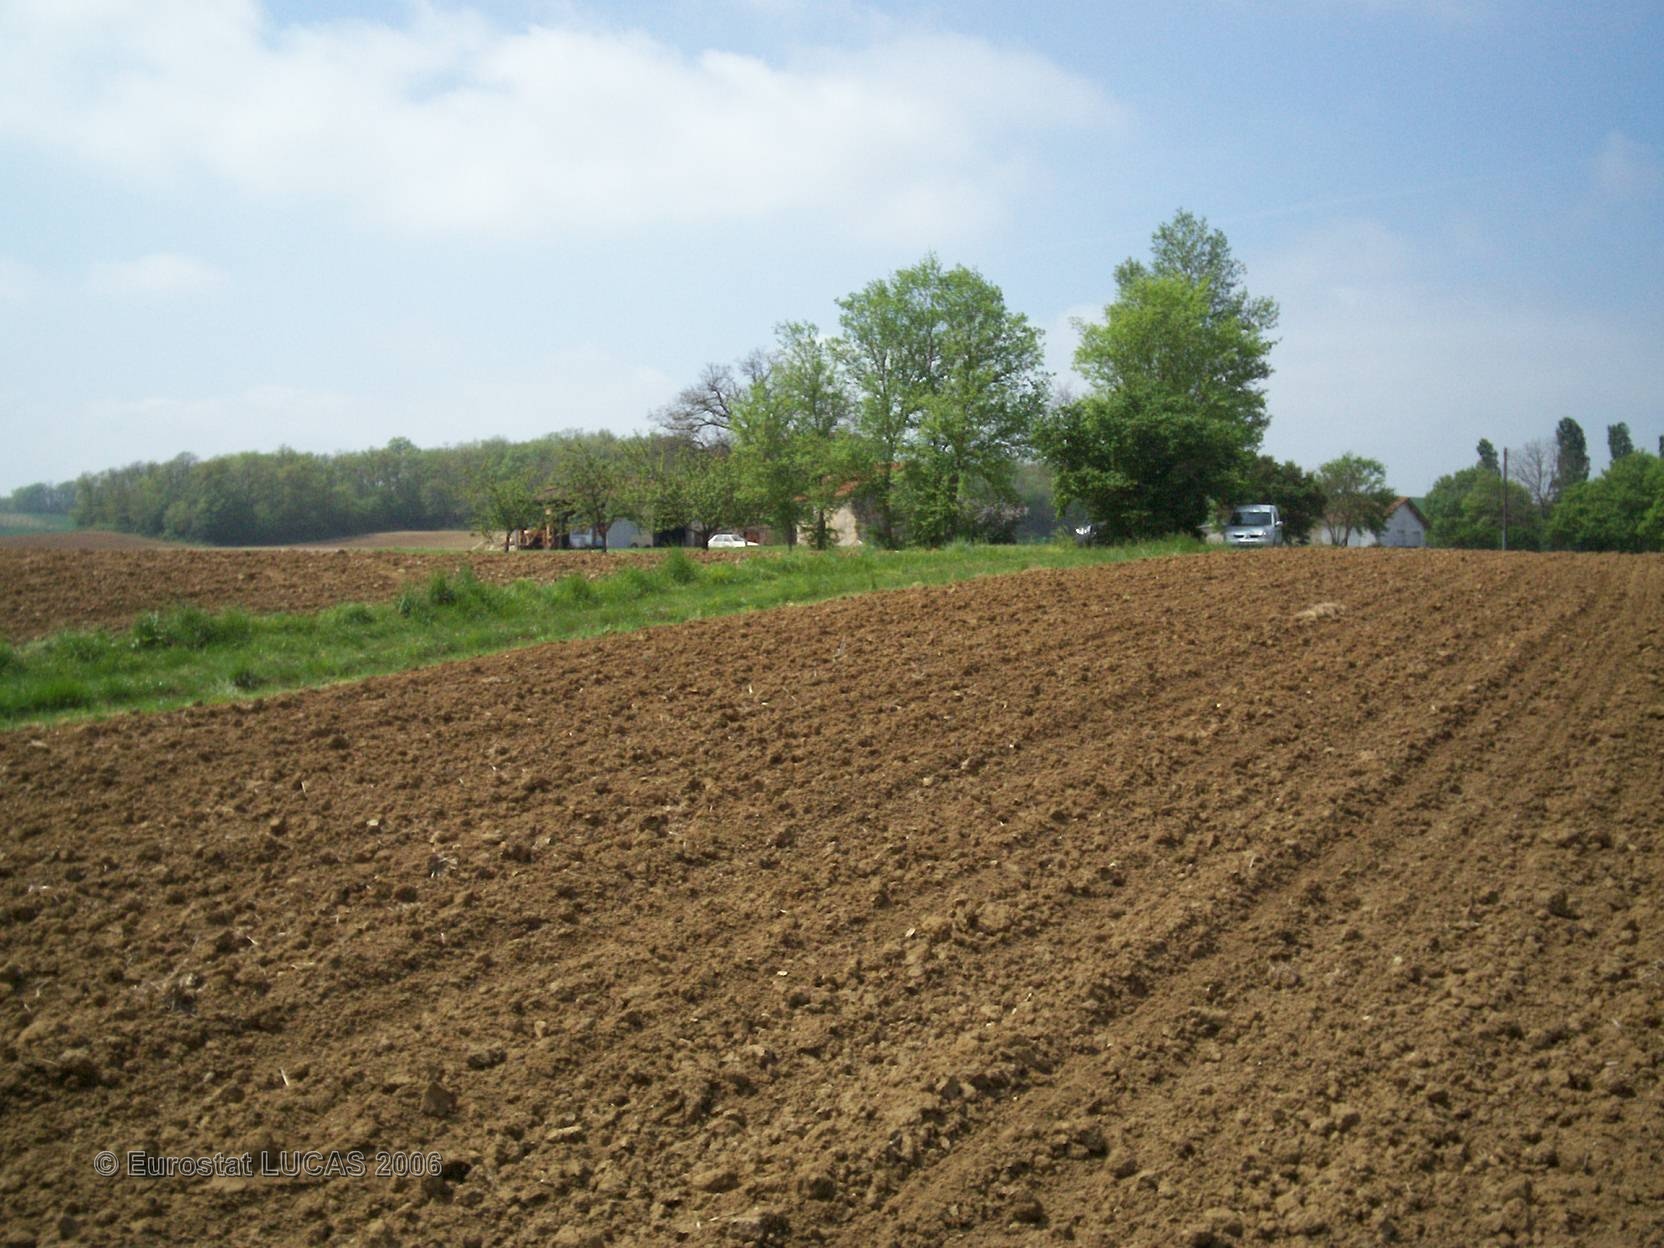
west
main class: Cropland
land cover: Sunflower
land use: Agriculture (excluding fallow land and kitchen gardens)
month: April
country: FR
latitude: 44.2465
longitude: 0.7660
